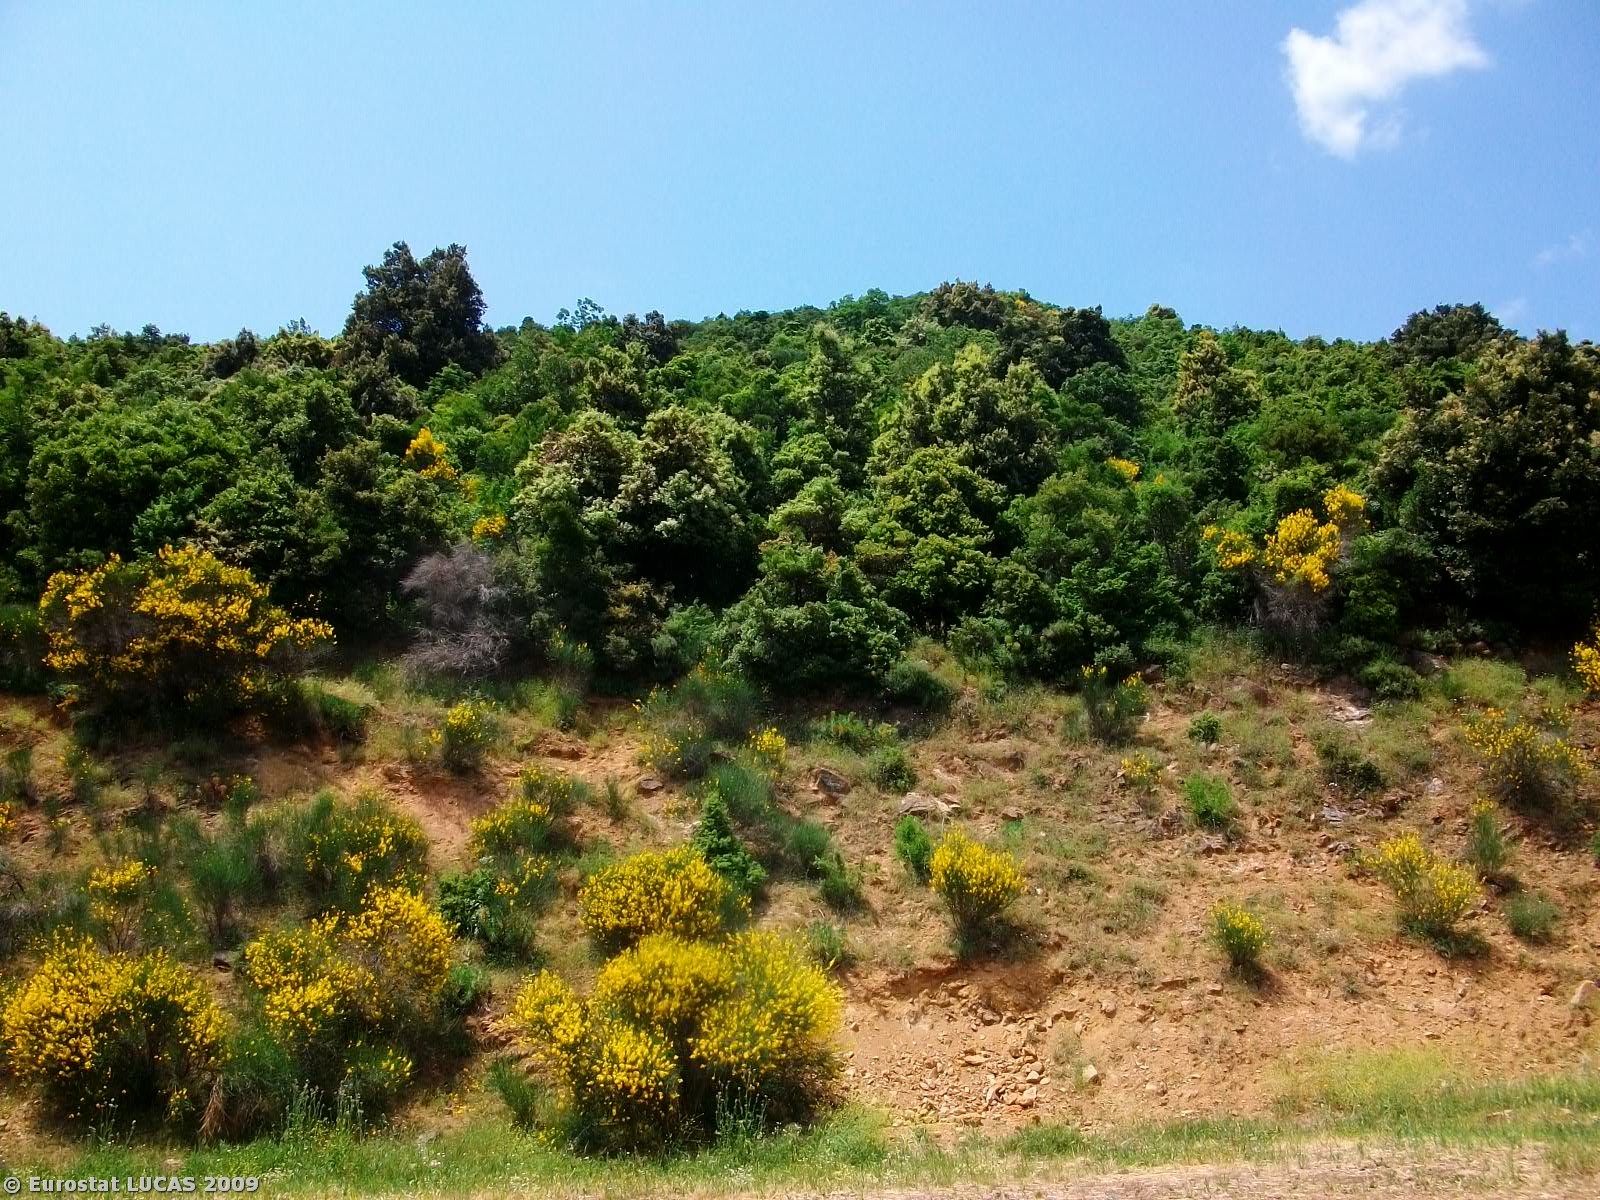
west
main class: Woodland
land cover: Mixed woodland
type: mesophytic deciduous forest
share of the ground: > 75 %
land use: Forestry
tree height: > 5 m
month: May
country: GR
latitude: 39.0858
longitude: 22.7372
